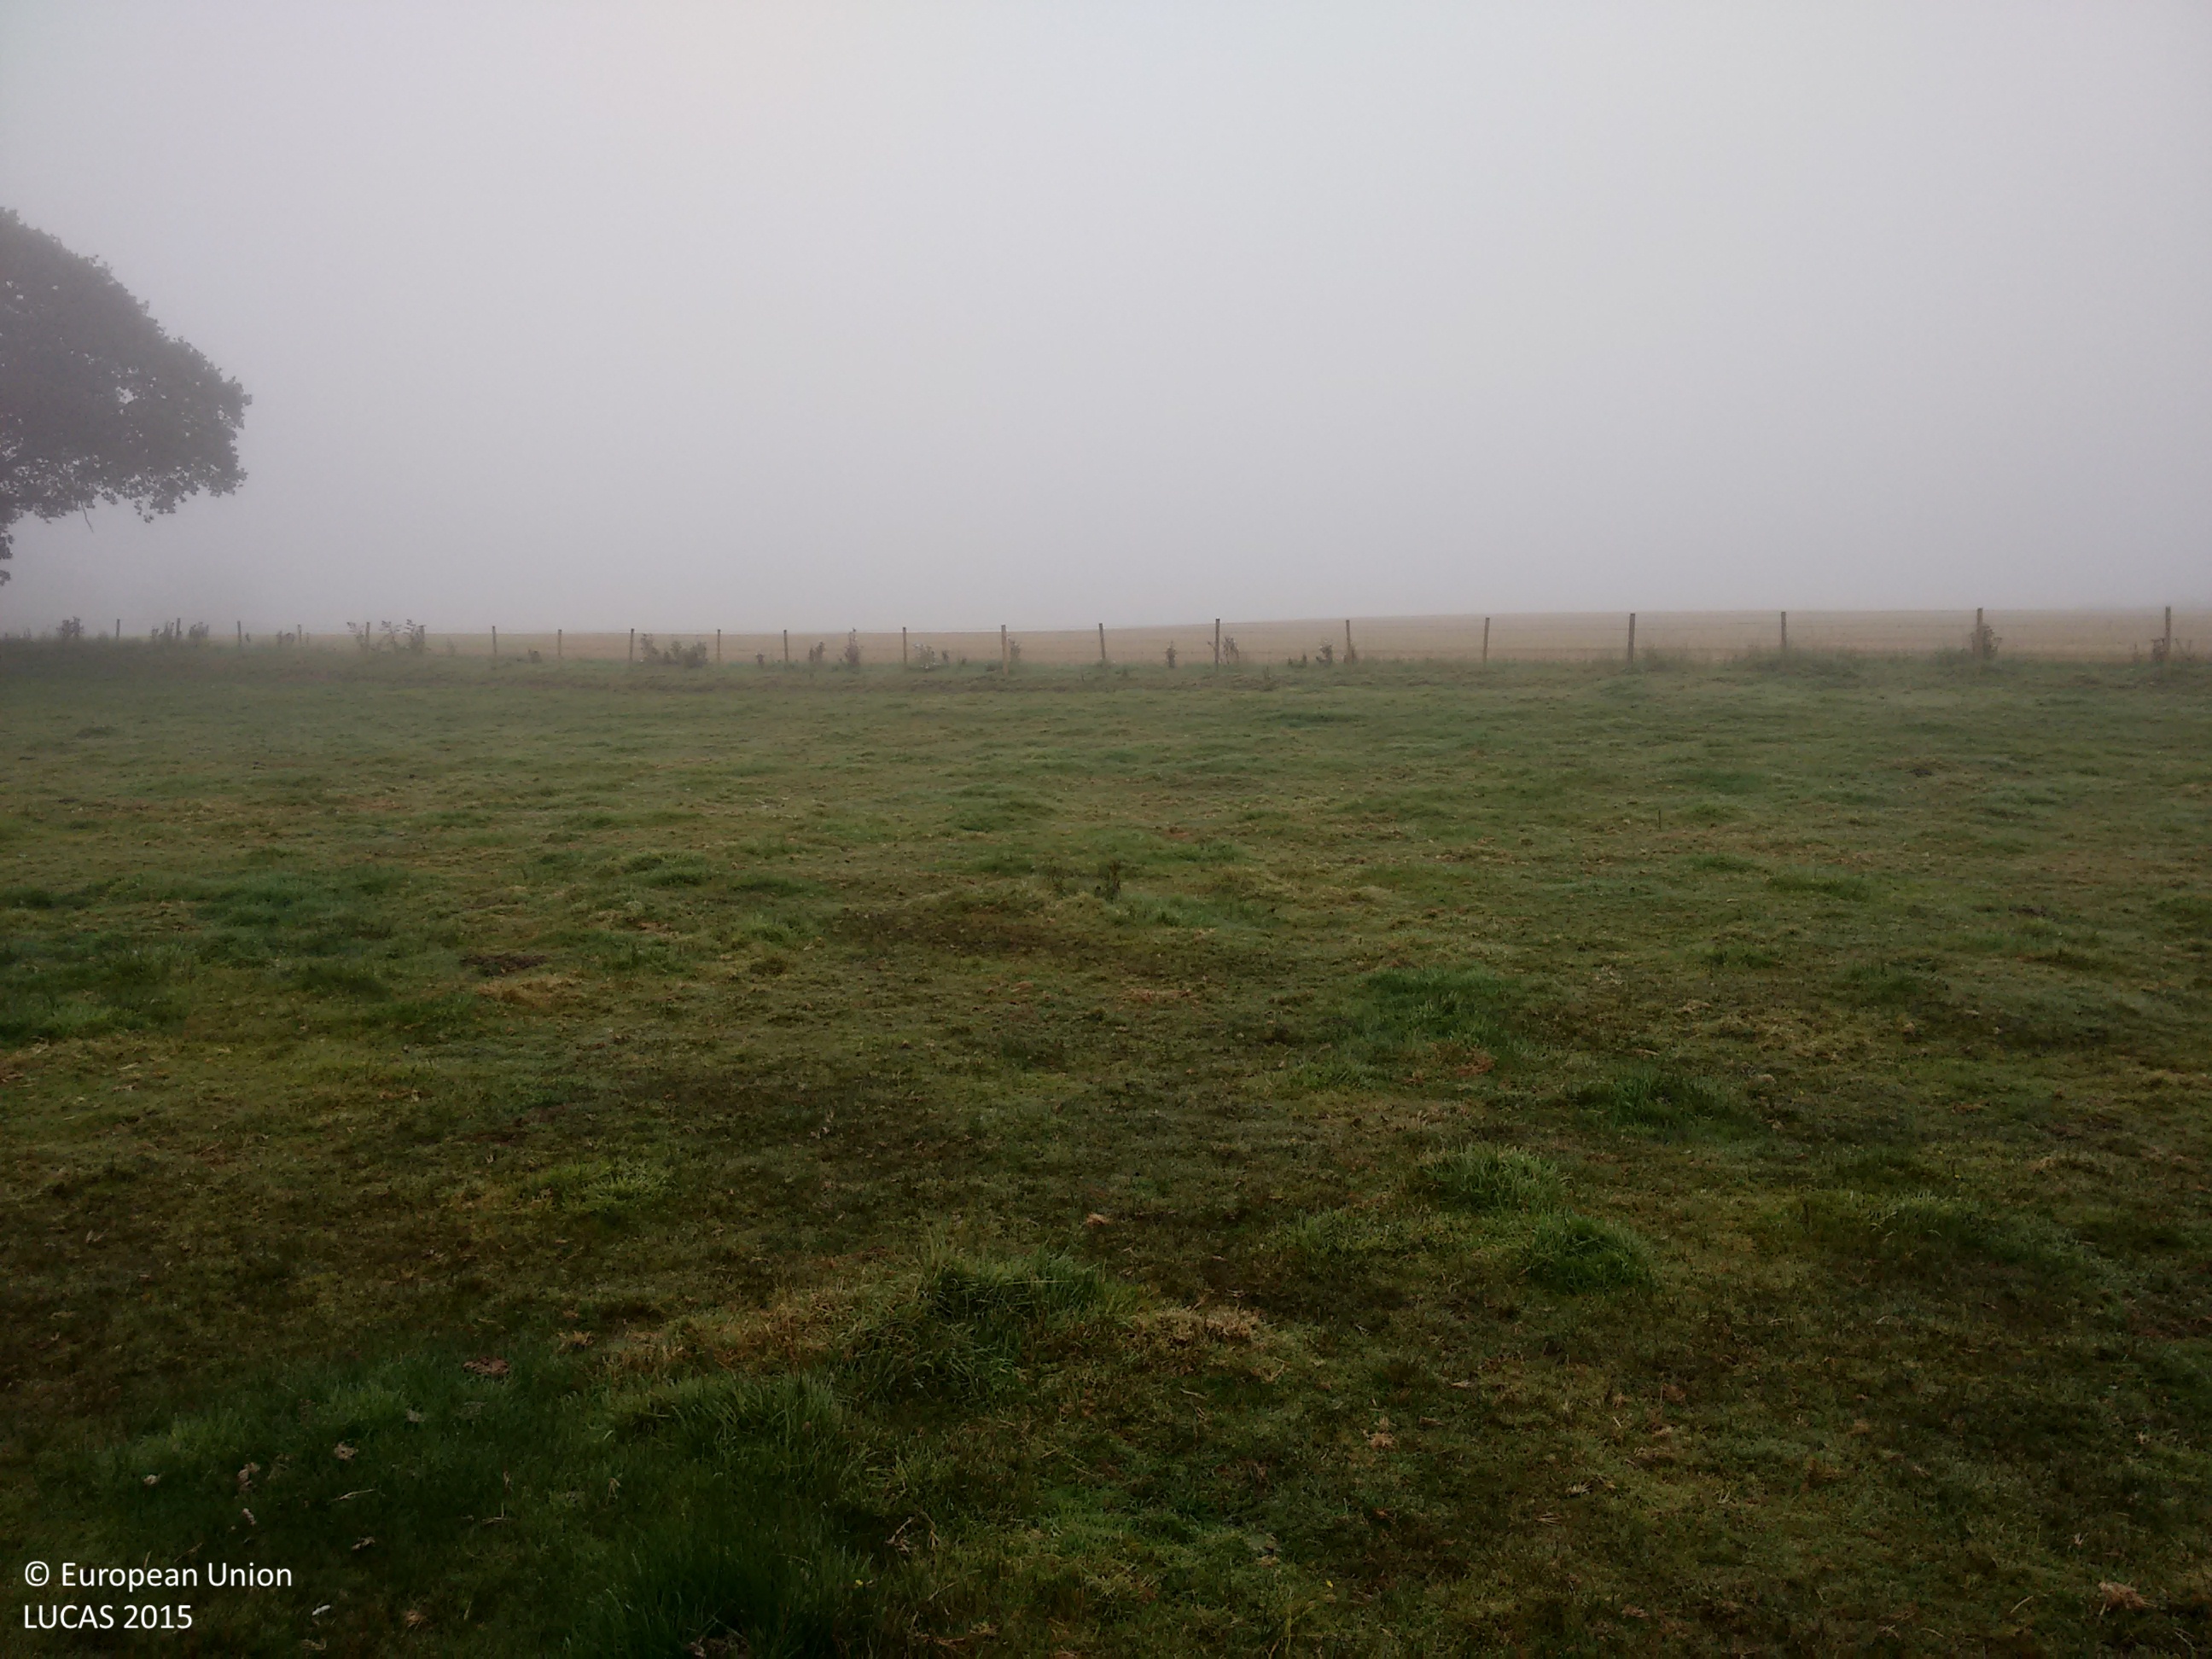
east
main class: Grassland
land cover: Grassland without tree/shrub cover
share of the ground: > 75 %
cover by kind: herbaceous plants 100 %
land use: Agriculture (excluding fallow land and kitchen gardens)
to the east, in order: Grassland without tree/shrub cover; Fences; Grass margins; Common wheat; Grass margins; Fences; Grass margins; Sugar beet
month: September
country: GB
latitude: 52.8135
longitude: -2.9371
